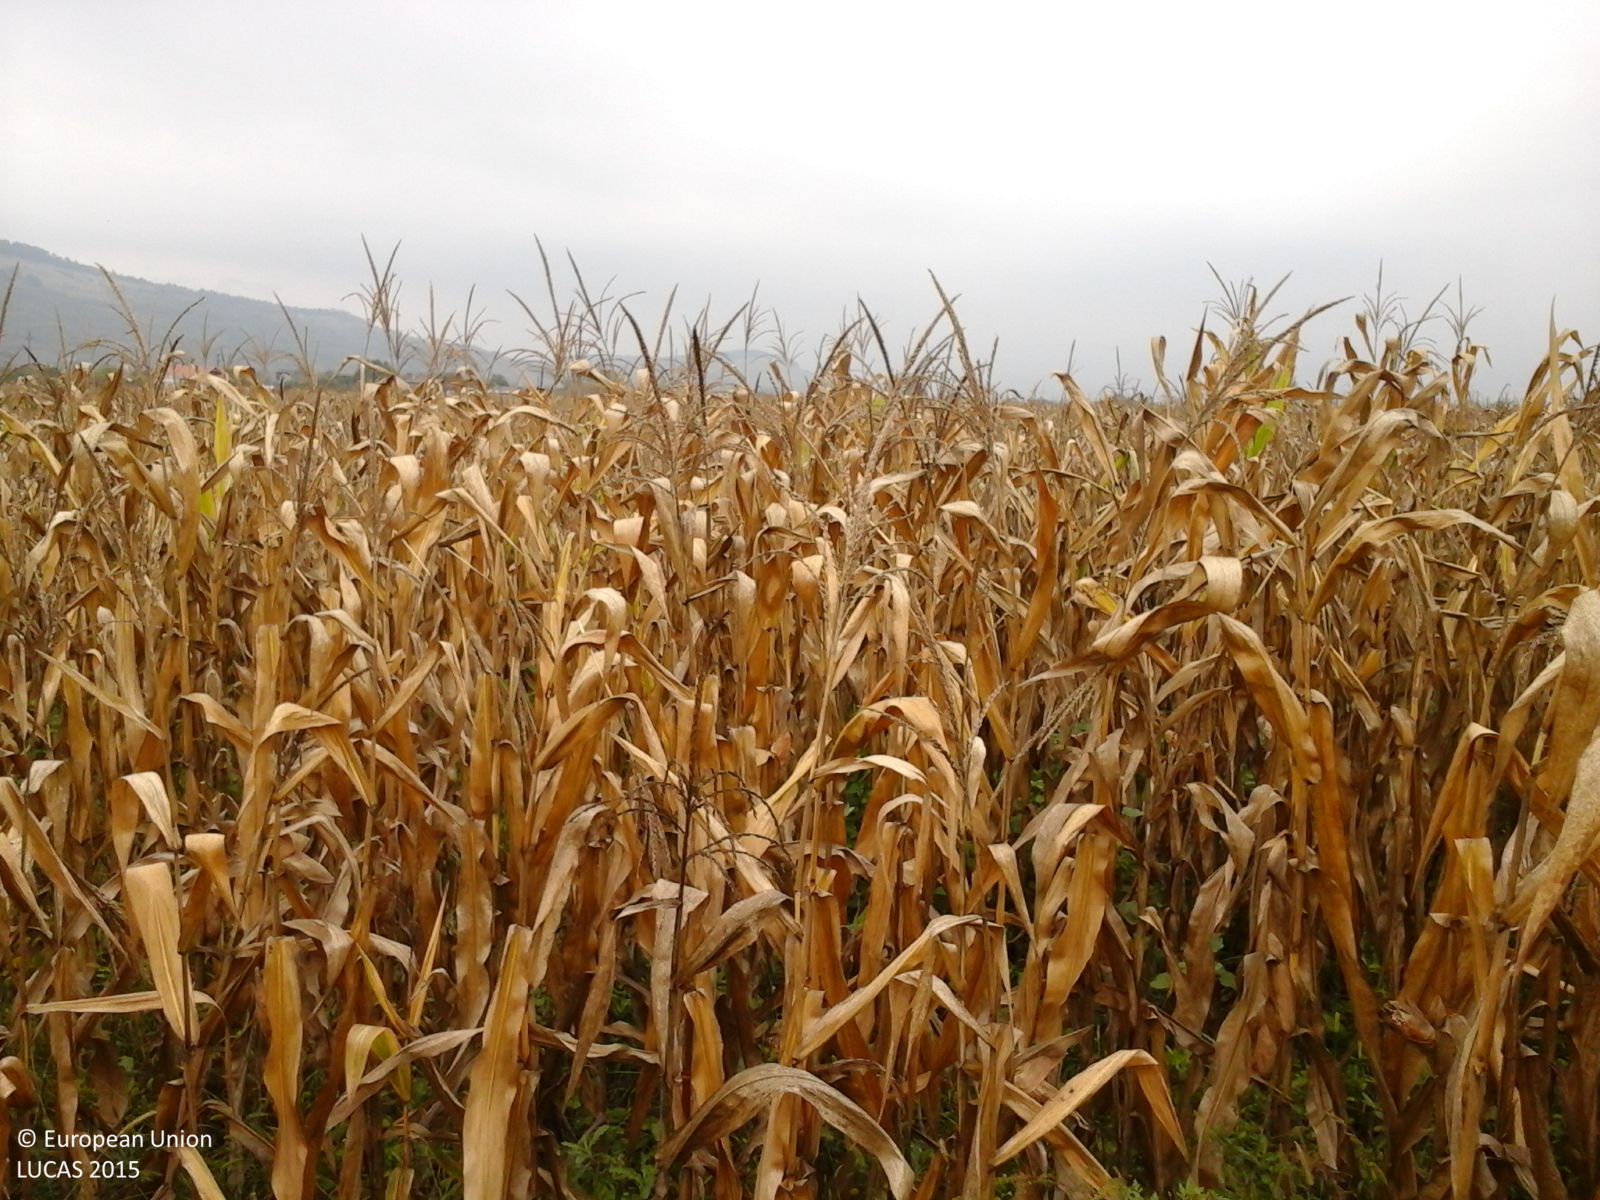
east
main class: Cropland
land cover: Maize
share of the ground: > 75 %
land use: Agriculture (excluding fallow land and kitchen gardens)
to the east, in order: Maize; Spontaneously vegetated surfaces; Common wheat; Spontaneously vegetated surfaces; Lucerne; Spontaneously vegetated surfaces; Maize; Electric lines; Grass margins; Tracks; Grassland without tree/shrub cover
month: September
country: RO
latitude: 45.9179
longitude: 22.8565
